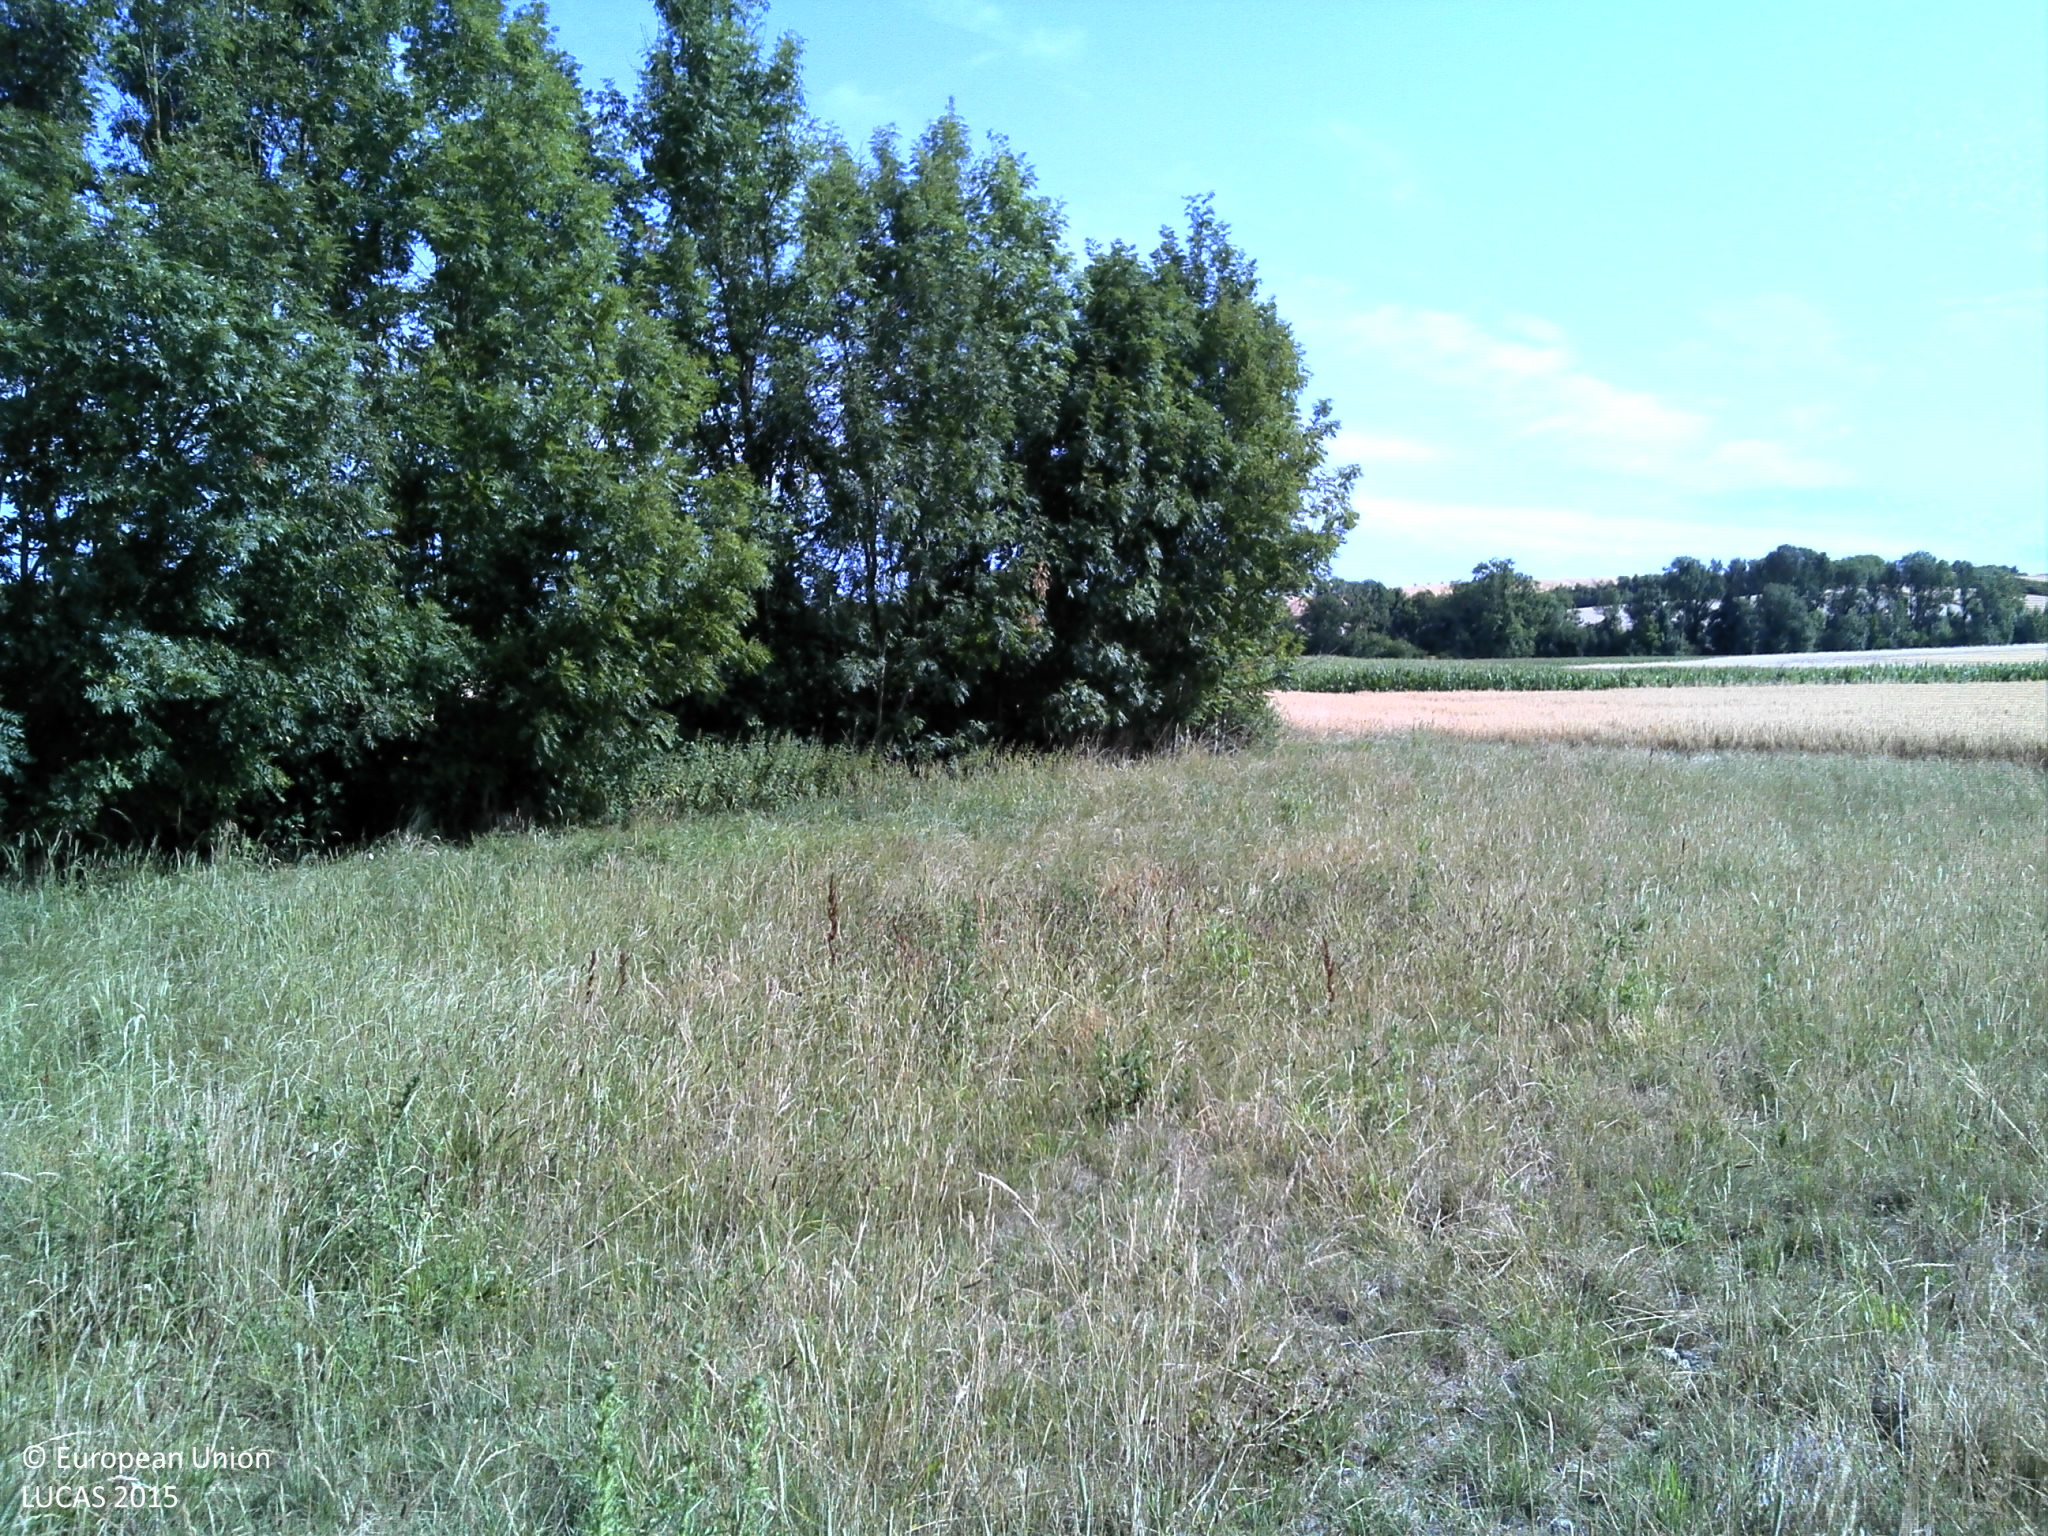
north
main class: Grassland
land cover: Grassland without tree/shrub cover
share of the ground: > 75 %
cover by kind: herbaceous plants 100 %
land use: Agriculture (excluding fallow land and kitchen gardens)
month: July
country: FR
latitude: 48.9146
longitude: 4.8533
